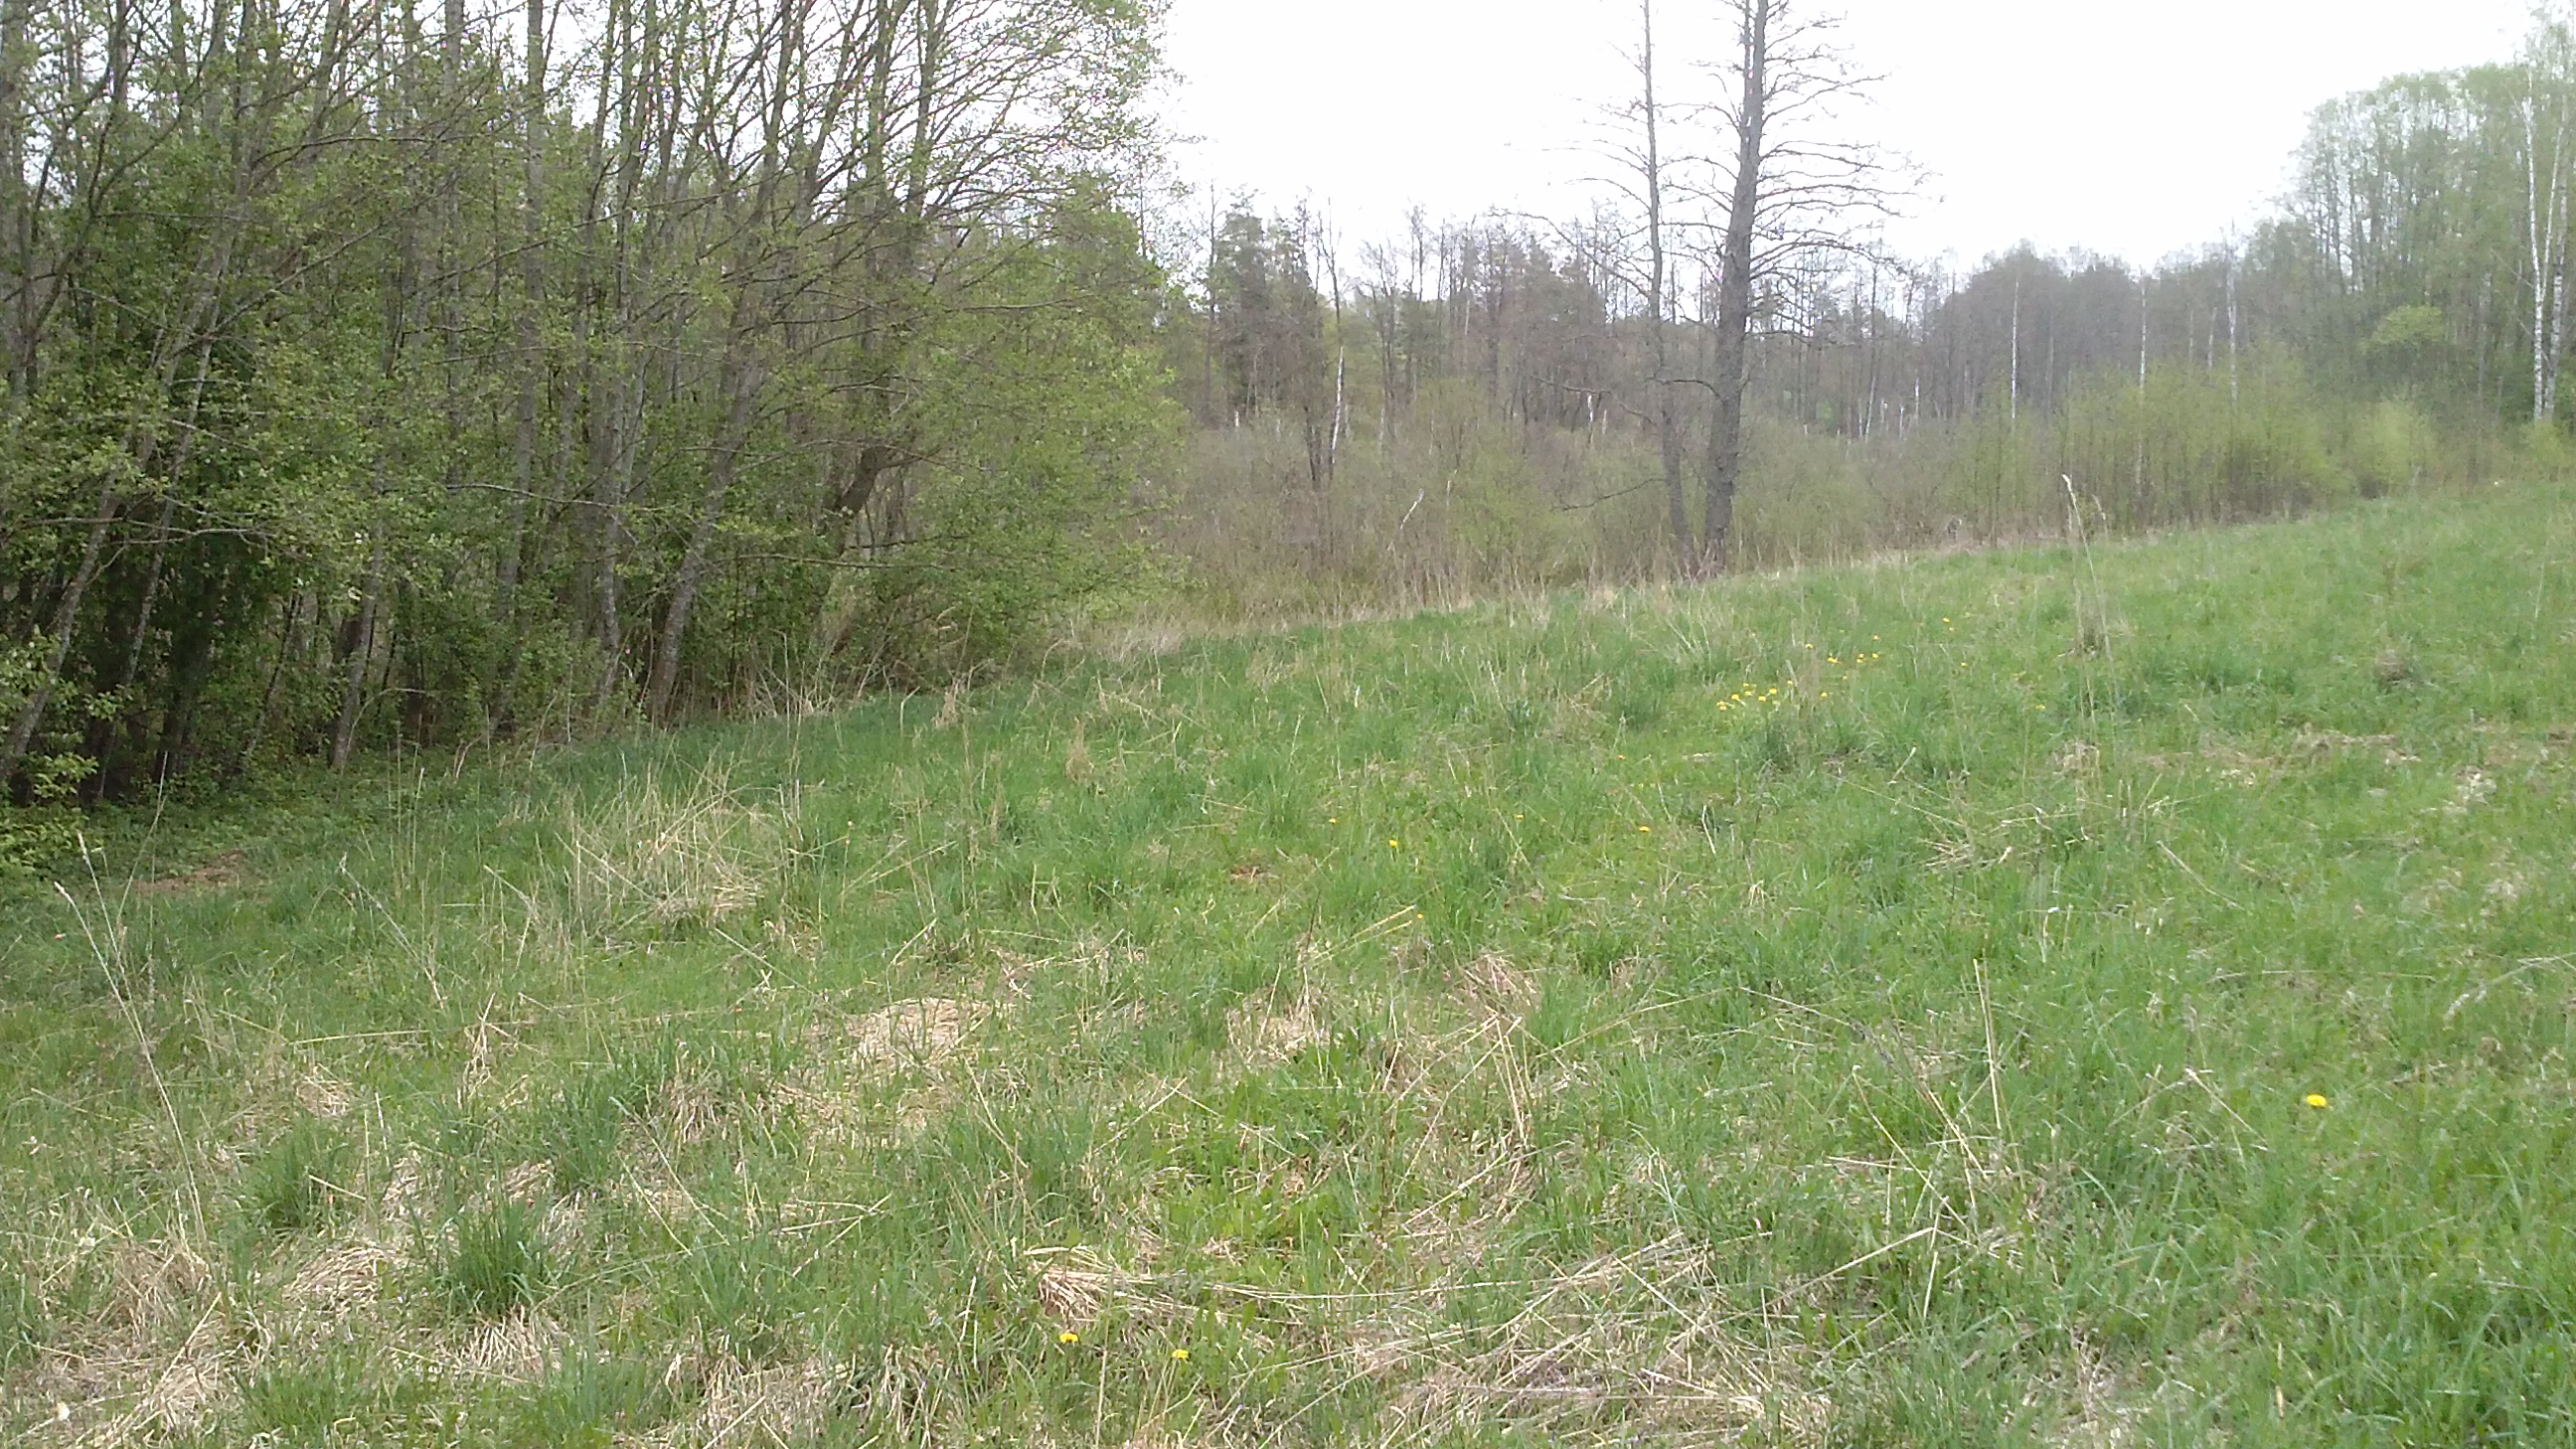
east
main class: Grassland
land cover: Grassland with sparse tree/shrub cover
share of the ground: > 75 %
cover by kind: herbaceous plants 90 %, broadleaved forest trees 5 %, shrubs 5 %
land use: Forestry
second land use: Agriculture (excluding fallow land and kitchen gardens)
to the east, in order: Grassland with sparse tree/shrub cover; Grassland without tree/shrub cover; Broadleaved woodland; Inland marshes; Broadleaved woodland; Grassland without tree/shrub cover; Broadleaved woodland; Grassland without tree/shrub cover; Broadleaved woodland
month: May
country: LV
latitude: 56.0270
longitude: 27.0637
